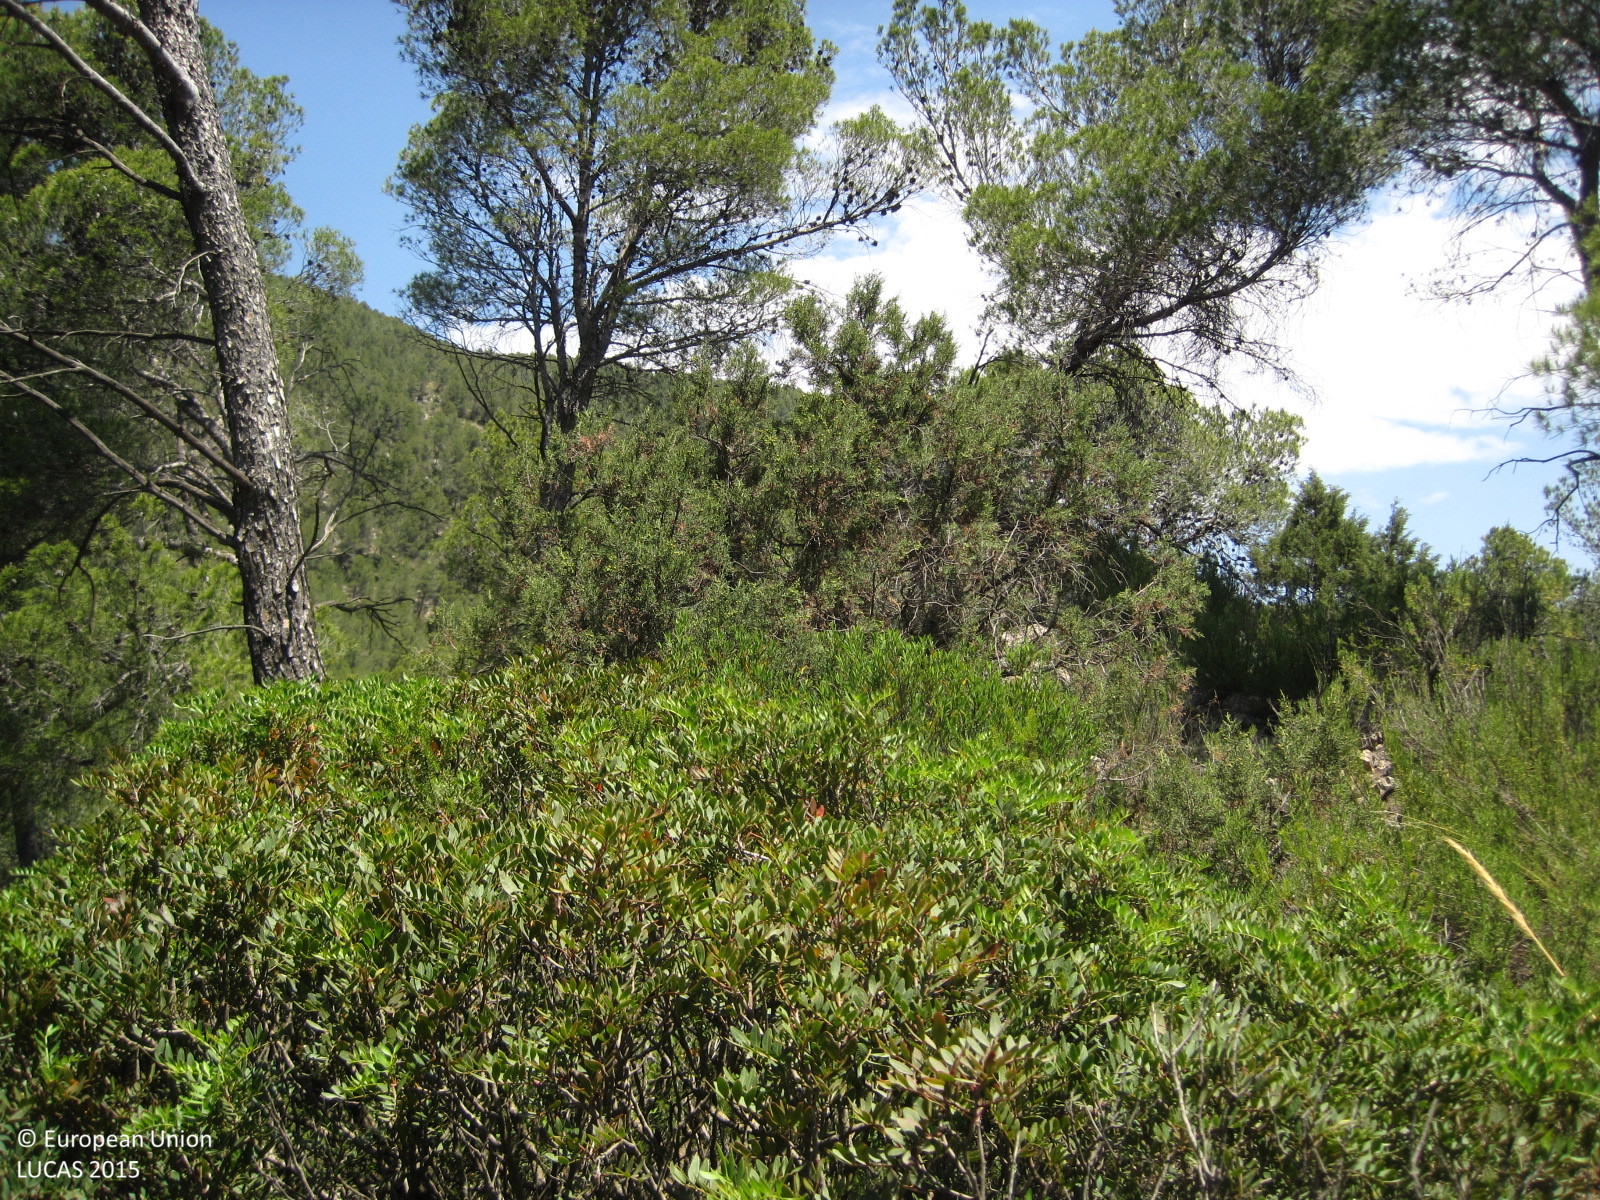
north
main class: Woodland
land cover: Pine dominated coniferous woodland
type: coniferous forest of the mediterranean region
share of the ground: 25 - 50 %
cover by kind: coniferous forest trees 40 %, shrubs 30 %, herbaceous plants 20 %, consolidated bare surface 10 %
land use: Forestry
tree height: > 5 m
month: June
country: ES
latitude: 39.7931
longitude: -1.1576
